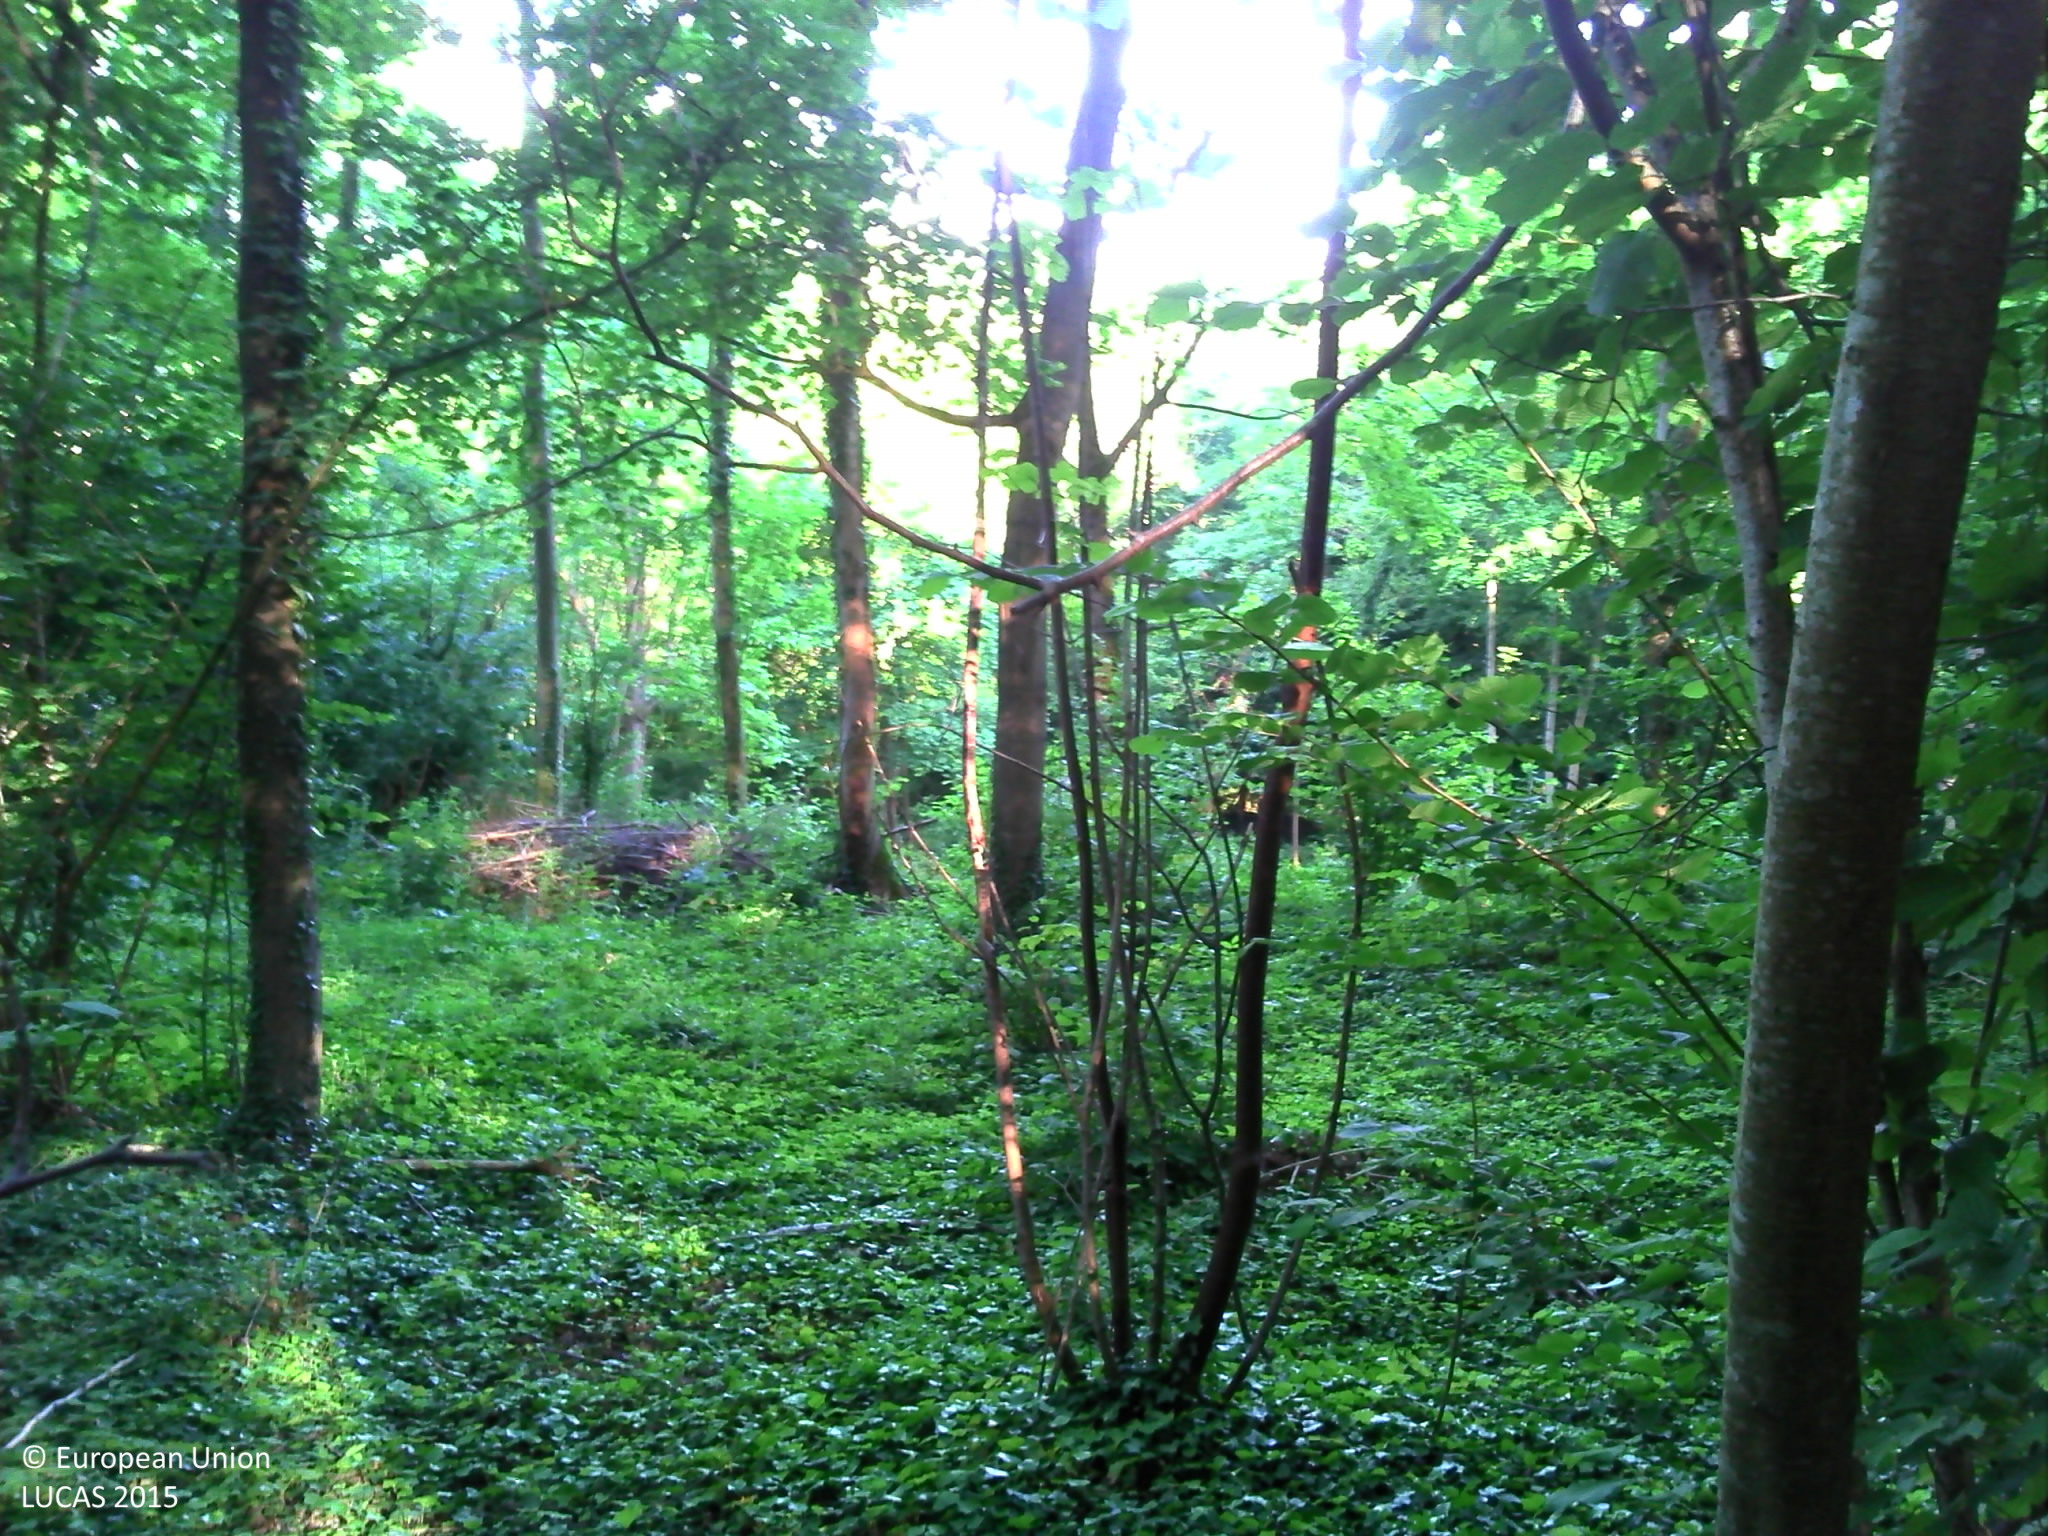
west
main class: Woodland
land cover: Broadleaved woodland
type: mesophytic deciduous forest
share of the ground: > 75 %
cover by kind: broadleaved forest trees 85 %, shrubs 10 %, herbaceous plants 5 %
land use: Forestry
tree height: > 5 m
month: June
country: FR
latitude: 49.2561
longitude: 2.8593
